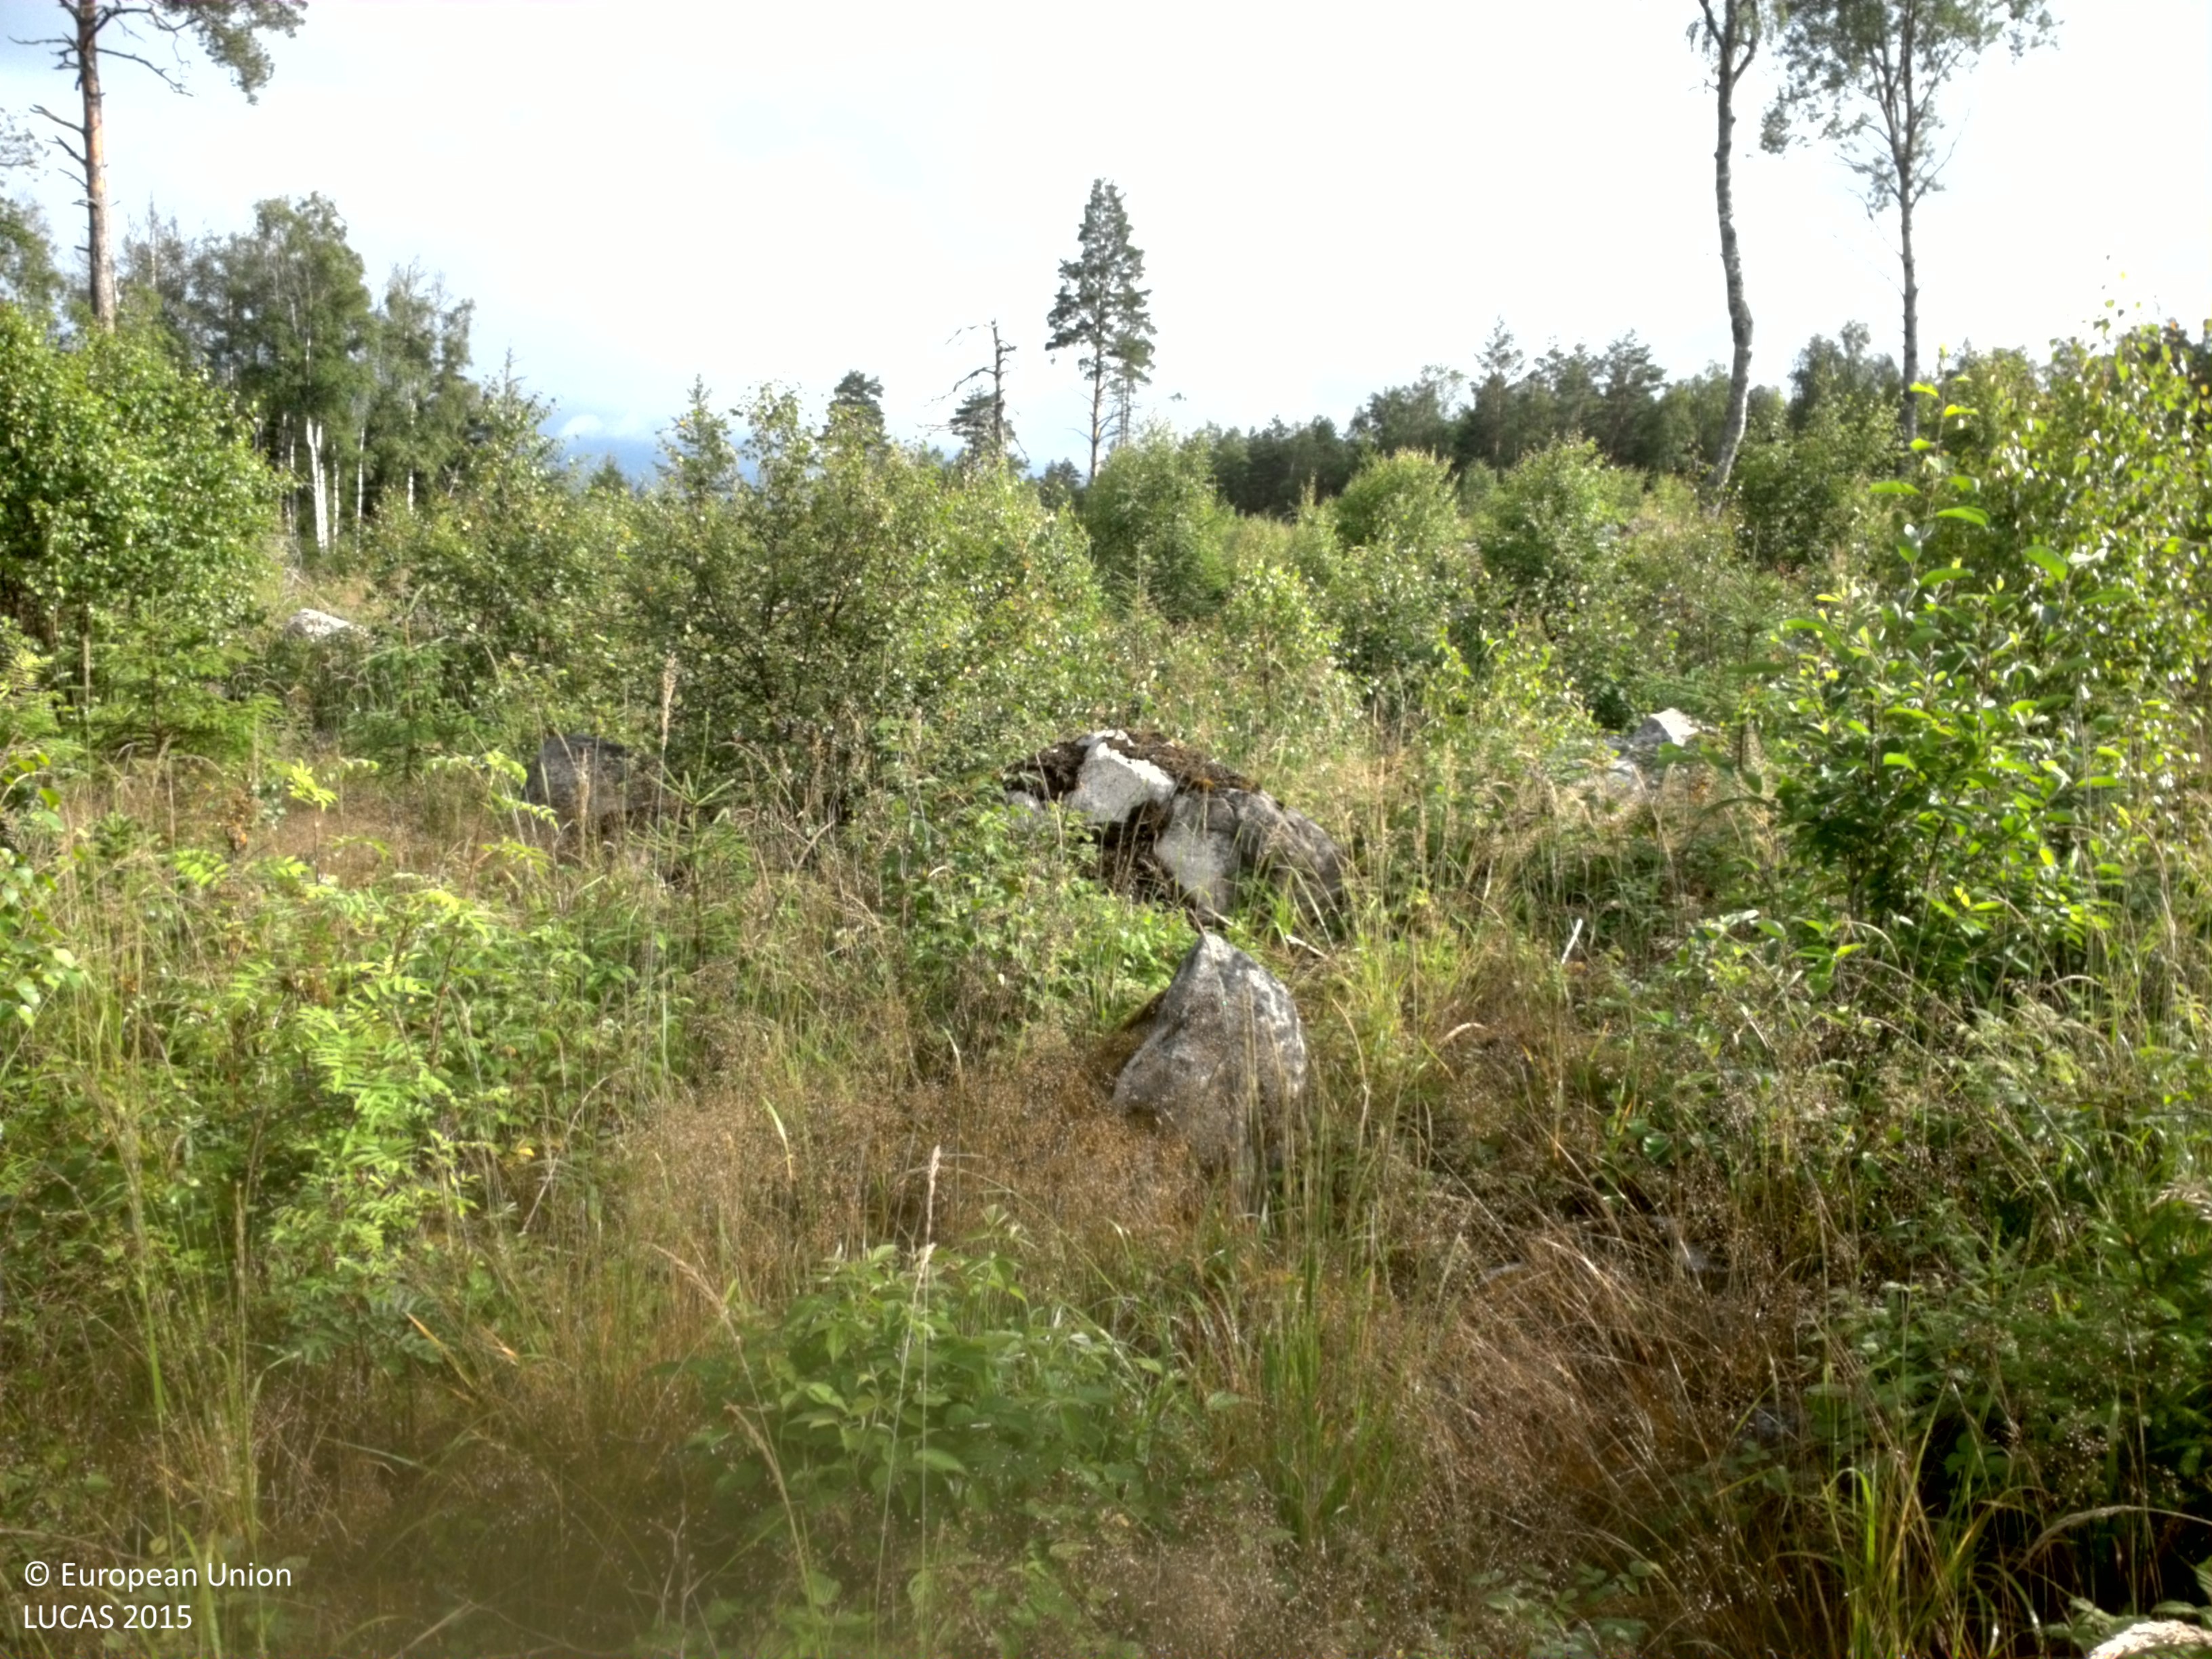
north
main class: Woodland
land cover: Broadleaved woodland
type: boreal forest
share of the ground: 25 - 50 %
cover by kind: herbaceous plants 50 %, broadleaved forest trees 40 %, coniferous forest trees 10 %
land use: Forestry
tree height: < 5 m
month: July
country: SE
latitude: 60.0656
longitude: 17.2683
